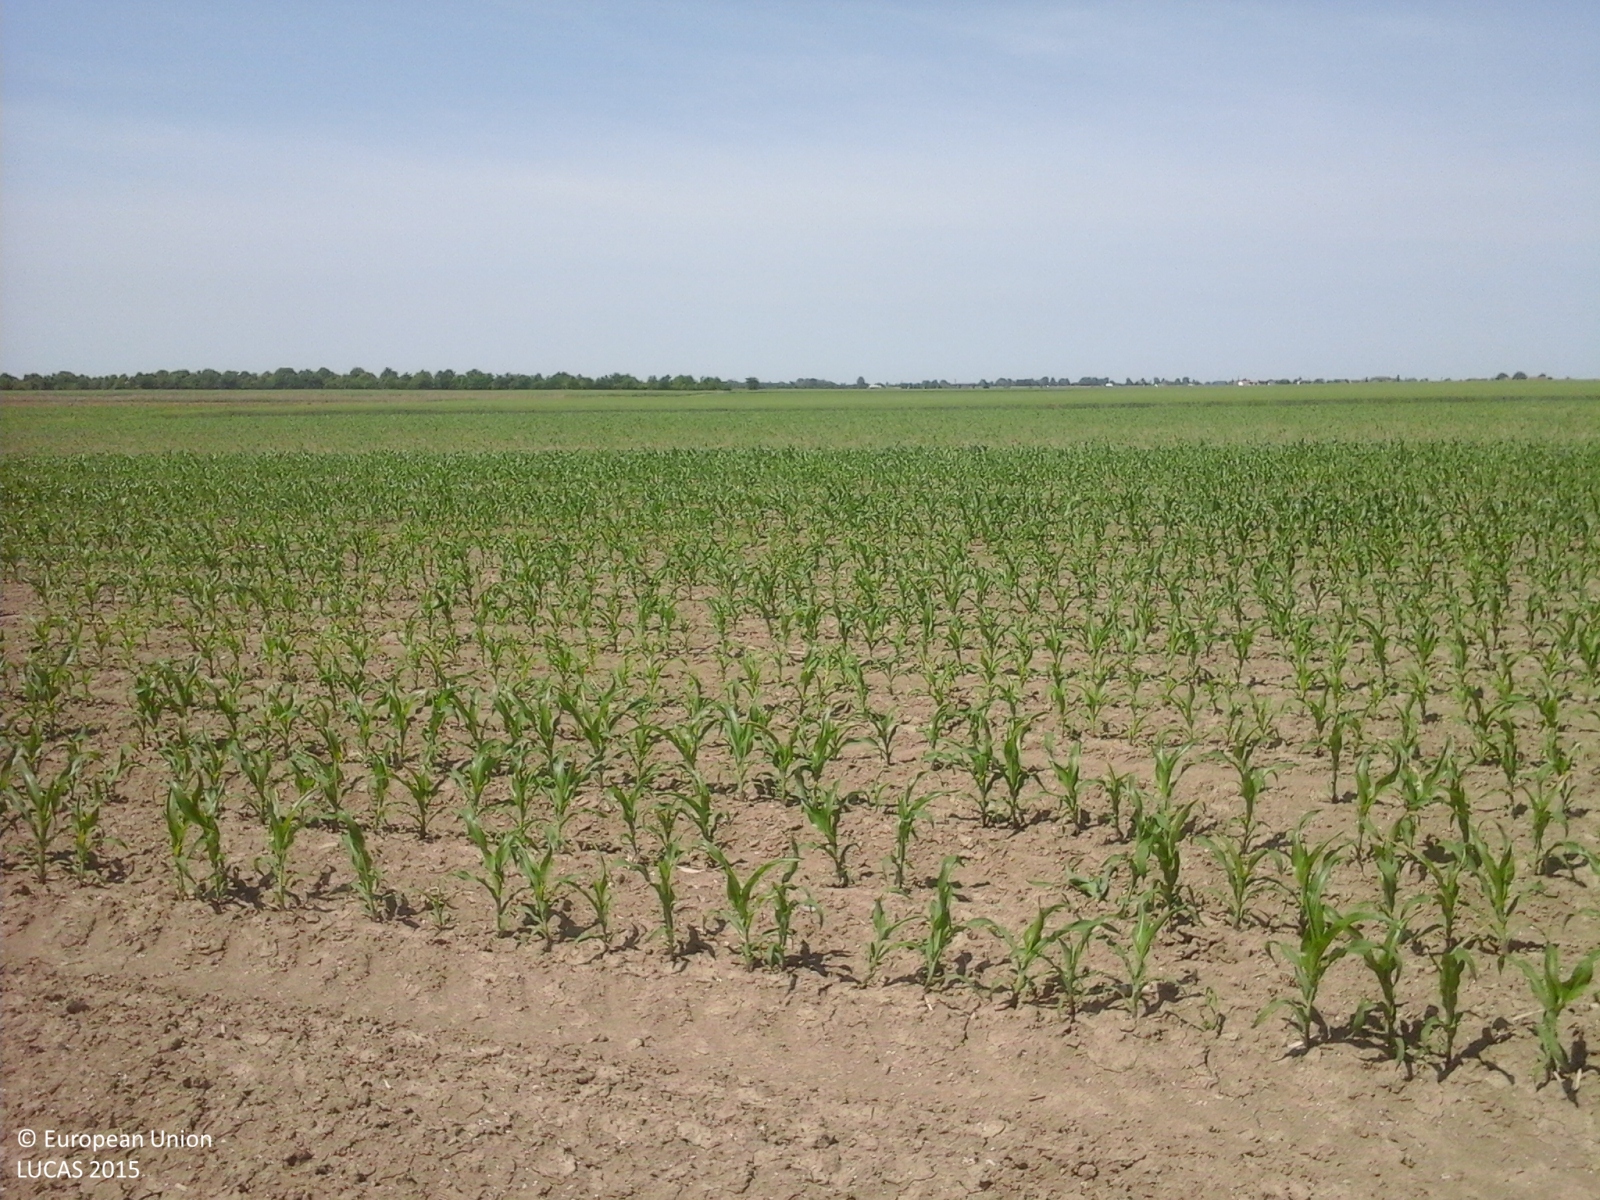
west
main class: Cropland
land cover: Maize
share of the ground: 10 - 25 %
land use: Agriculture (excluding fallow land and kitchen gardens)
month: May
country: IT
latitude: 44.9682
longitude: 11.6831
